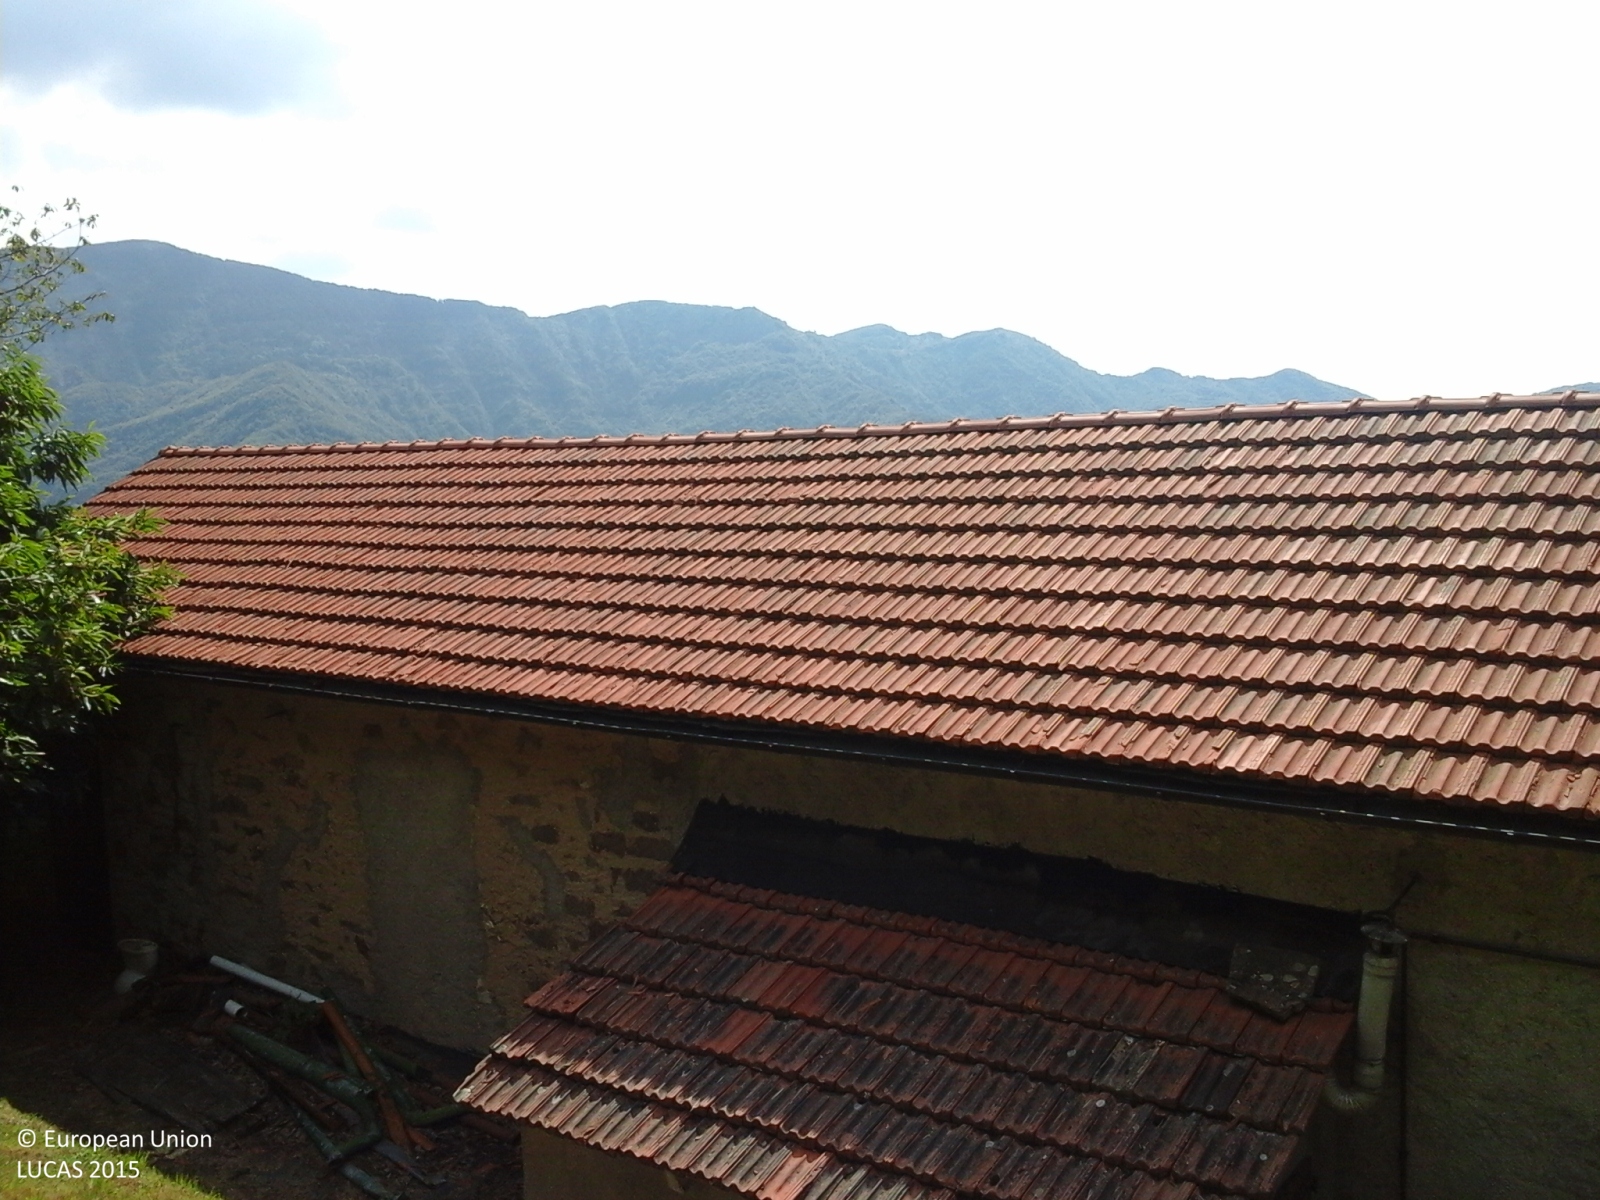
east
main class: Woodland
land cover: Broadleaved woodland
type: thermophilous deciduous forest
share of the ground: > 75 %
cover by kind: broadleaved forest trees 100 %
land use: Forestry
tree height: > 5 m
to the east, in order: Broadleaved woodland; Grassland without tree/shrub cover; Artificial constructions in urban areas; Grassland with sparse tree/shrub cover; Artificial constructions in urban areas; Broadleaved woodland; Paved roads, cycling and walking lanes; Fences; Grassland with sparse tree/shrub cover; Fences; Artificial constructions in urban areas; Grassland with sparse tree/shrub cover
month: June
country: IT
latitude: 44.0928
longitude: 11.0342
